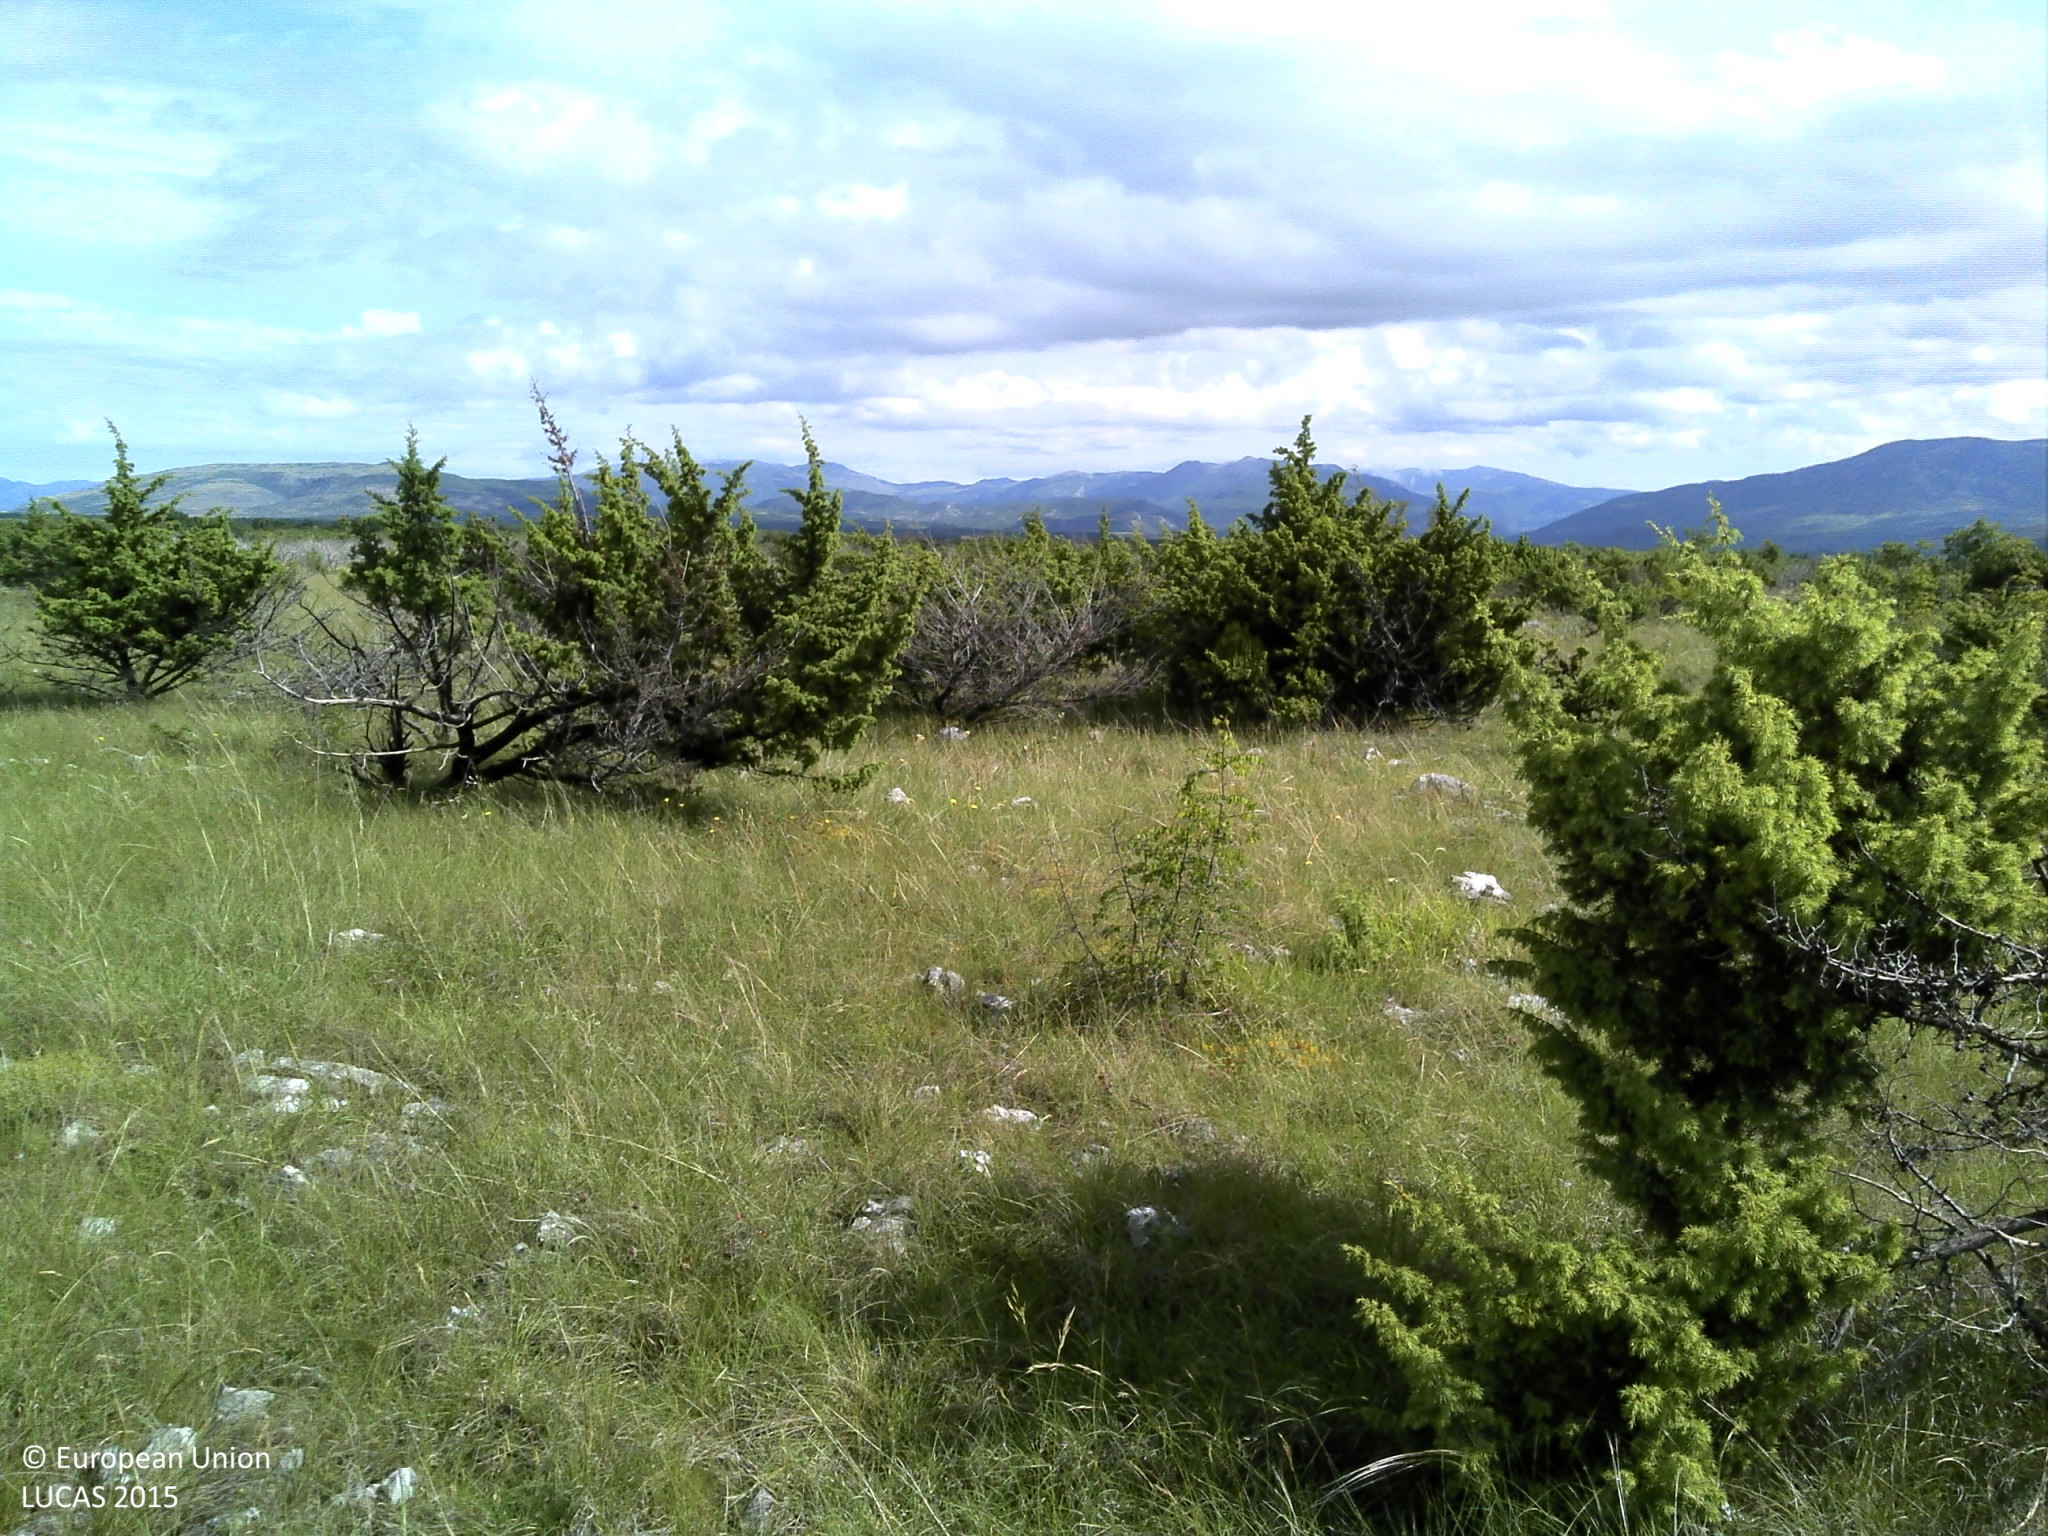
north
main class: Grassland
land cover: Grassland with sparse tree/shrub cover
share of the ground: > 75 %
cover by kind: herbaceous plants 75 %, shrubs 10 %, unconsolidated bare surface 10 %, coniferous forest trees 5 %
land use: Semi-natural and natural areas not in use
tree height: < 5 m
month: May
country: HR
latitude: 43.9849
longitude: 16.1888
